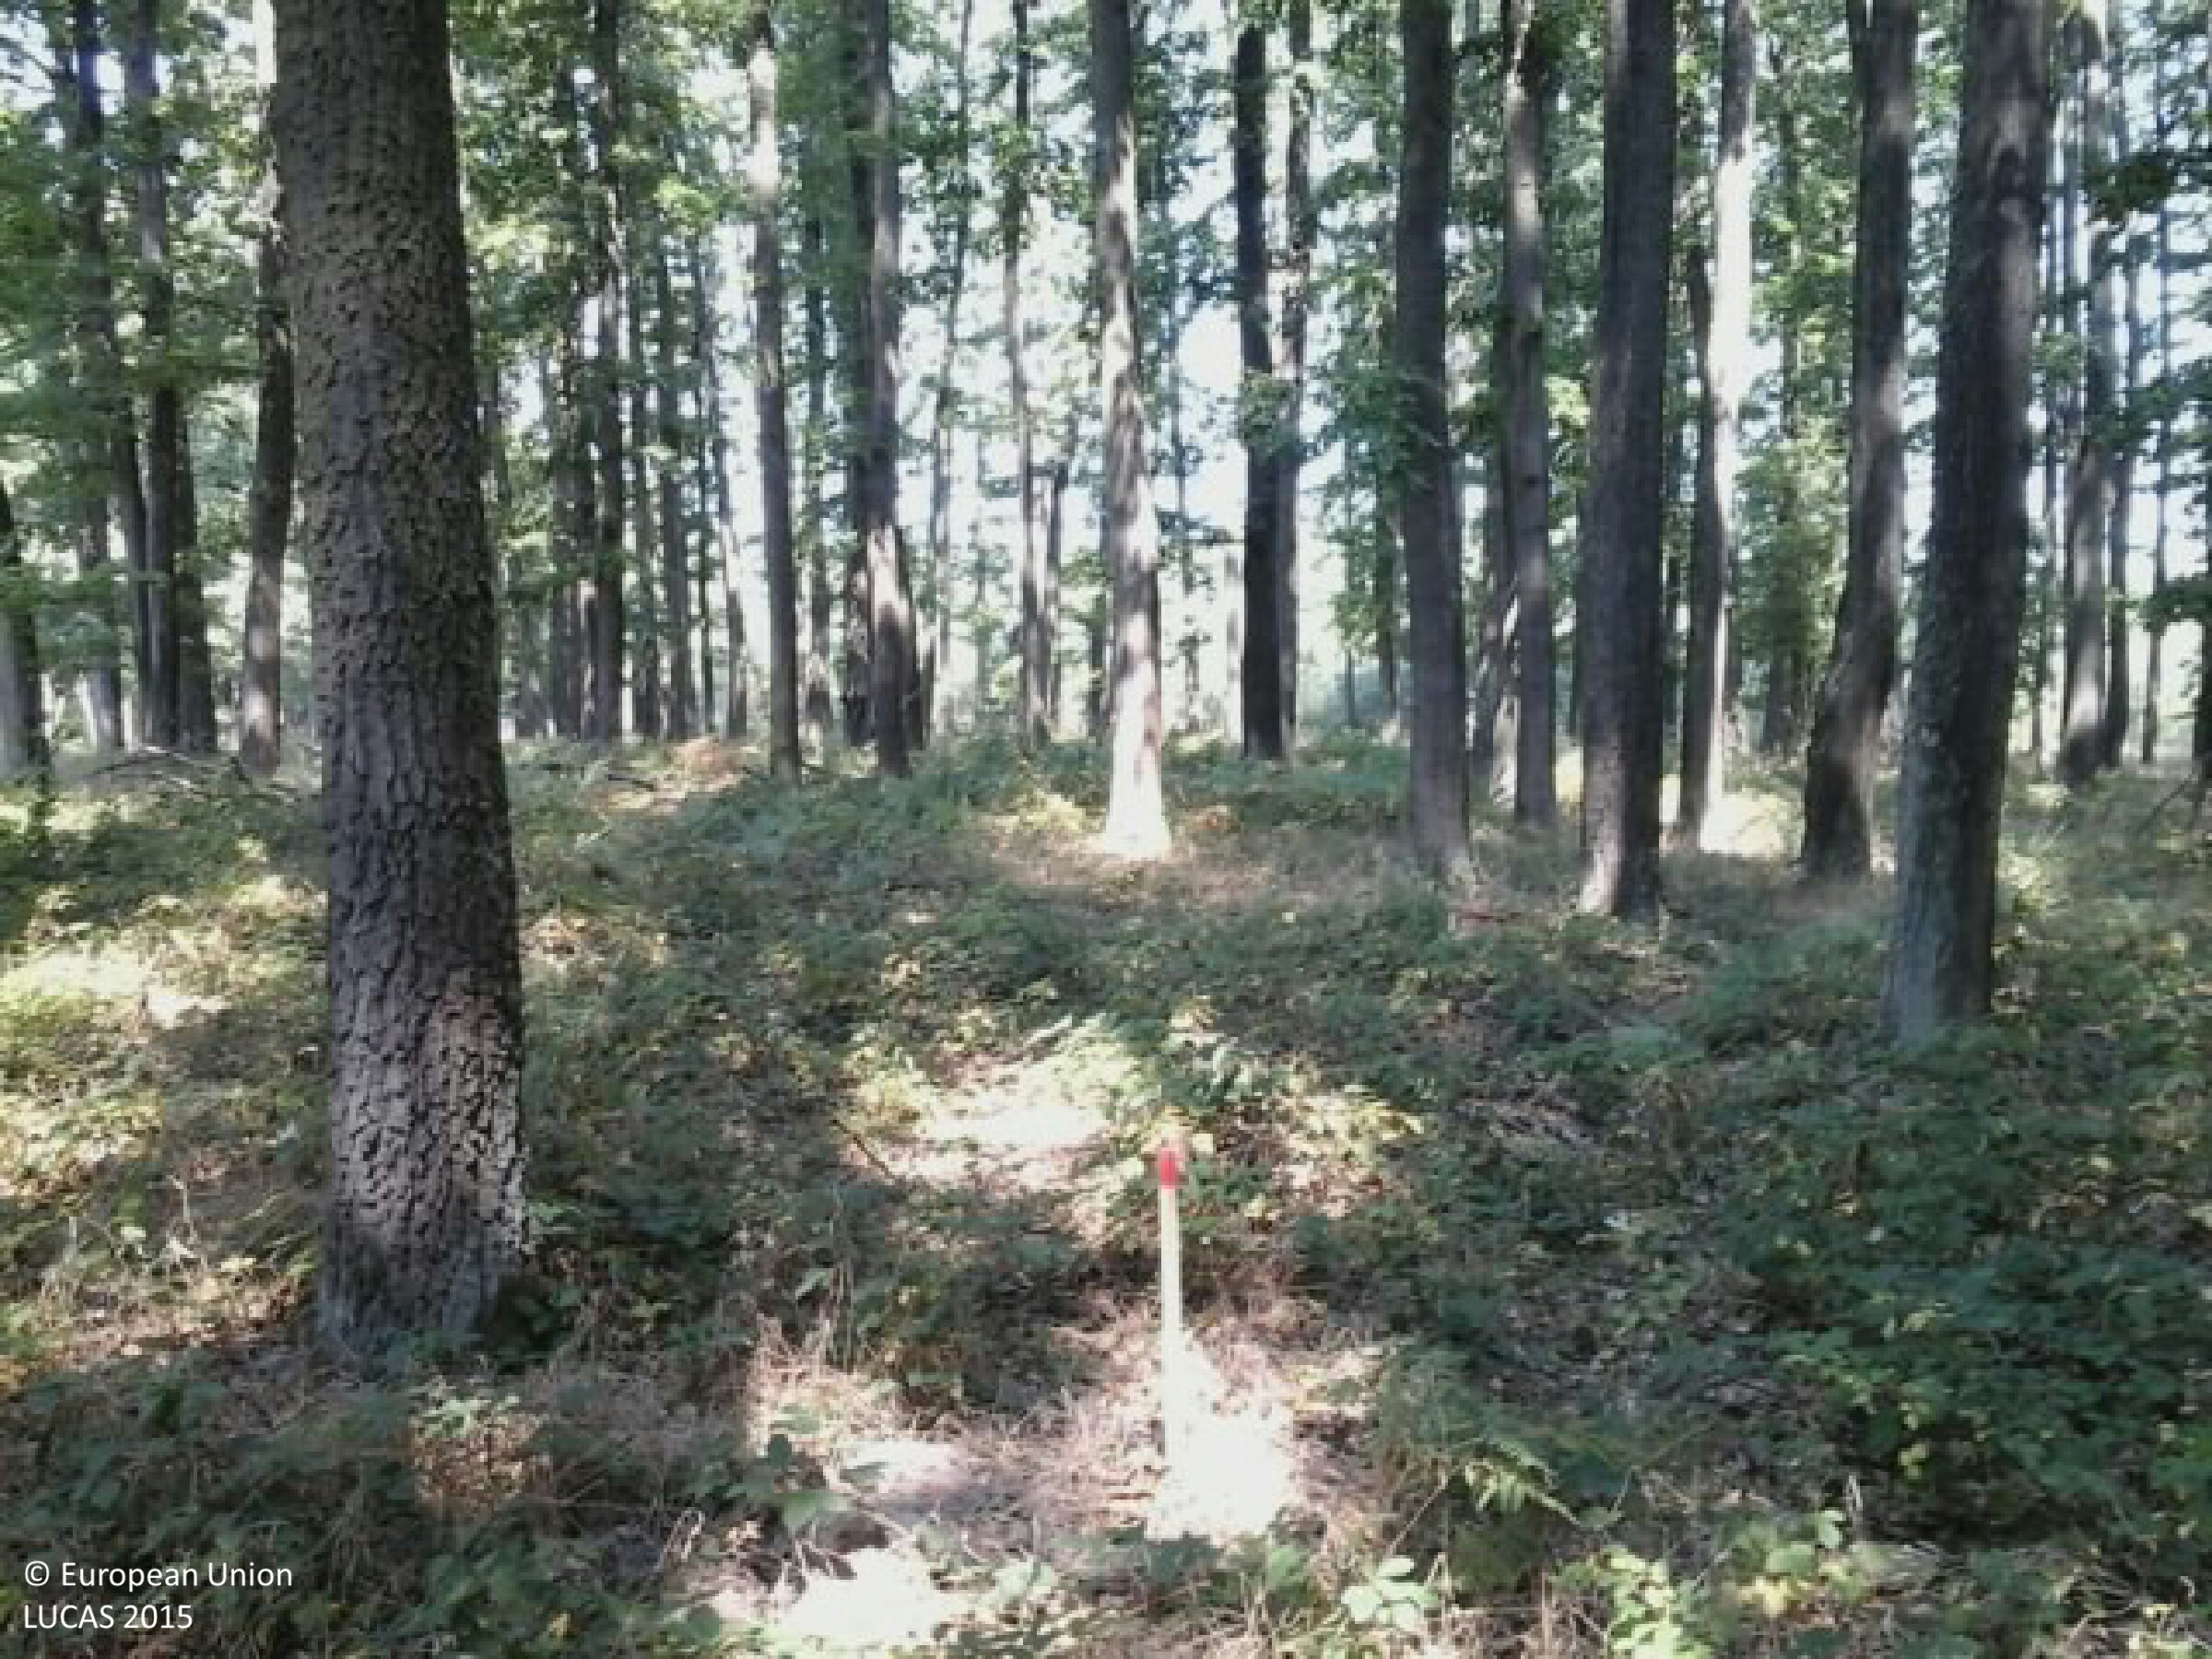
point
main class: Woodland
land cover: Broadleaved woodland
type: mesophytic deciduous forest
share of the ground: > 75 %
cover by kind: broadleaved forest trees 95 %, shrubs 5 %
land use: Forestry
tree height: > 5 m
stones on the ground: < 10 %
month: August
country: HU
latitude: 46.1957
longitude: 17.2465
